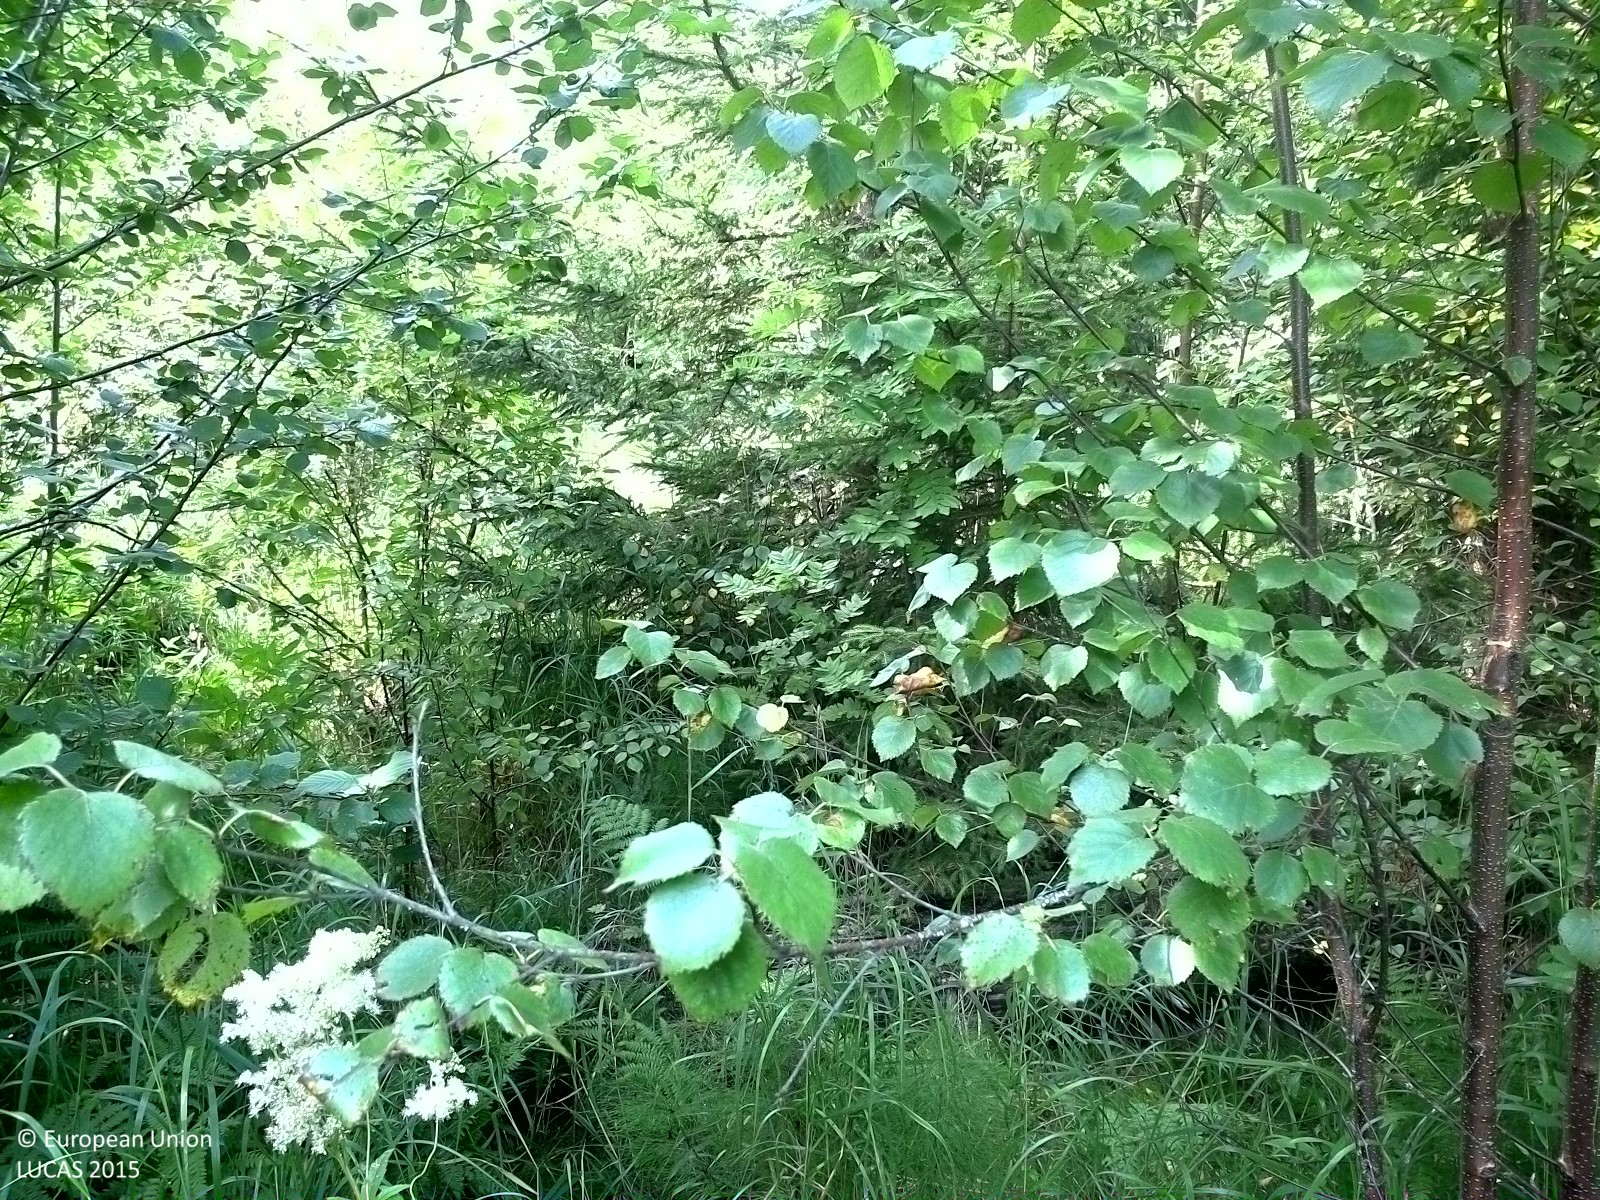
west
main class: Woodland
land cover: Other mixed woodland
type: boreal forest
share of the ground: 50 - 75 %
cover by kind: herbaceous plants 45 %, broadleaved forest trees 40 %, coniferous forest trees 15 %
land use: Semi-natural and natural areas not in use
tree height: < 5 m
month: August
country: SE
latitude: 62.5114
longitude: 17.2233
